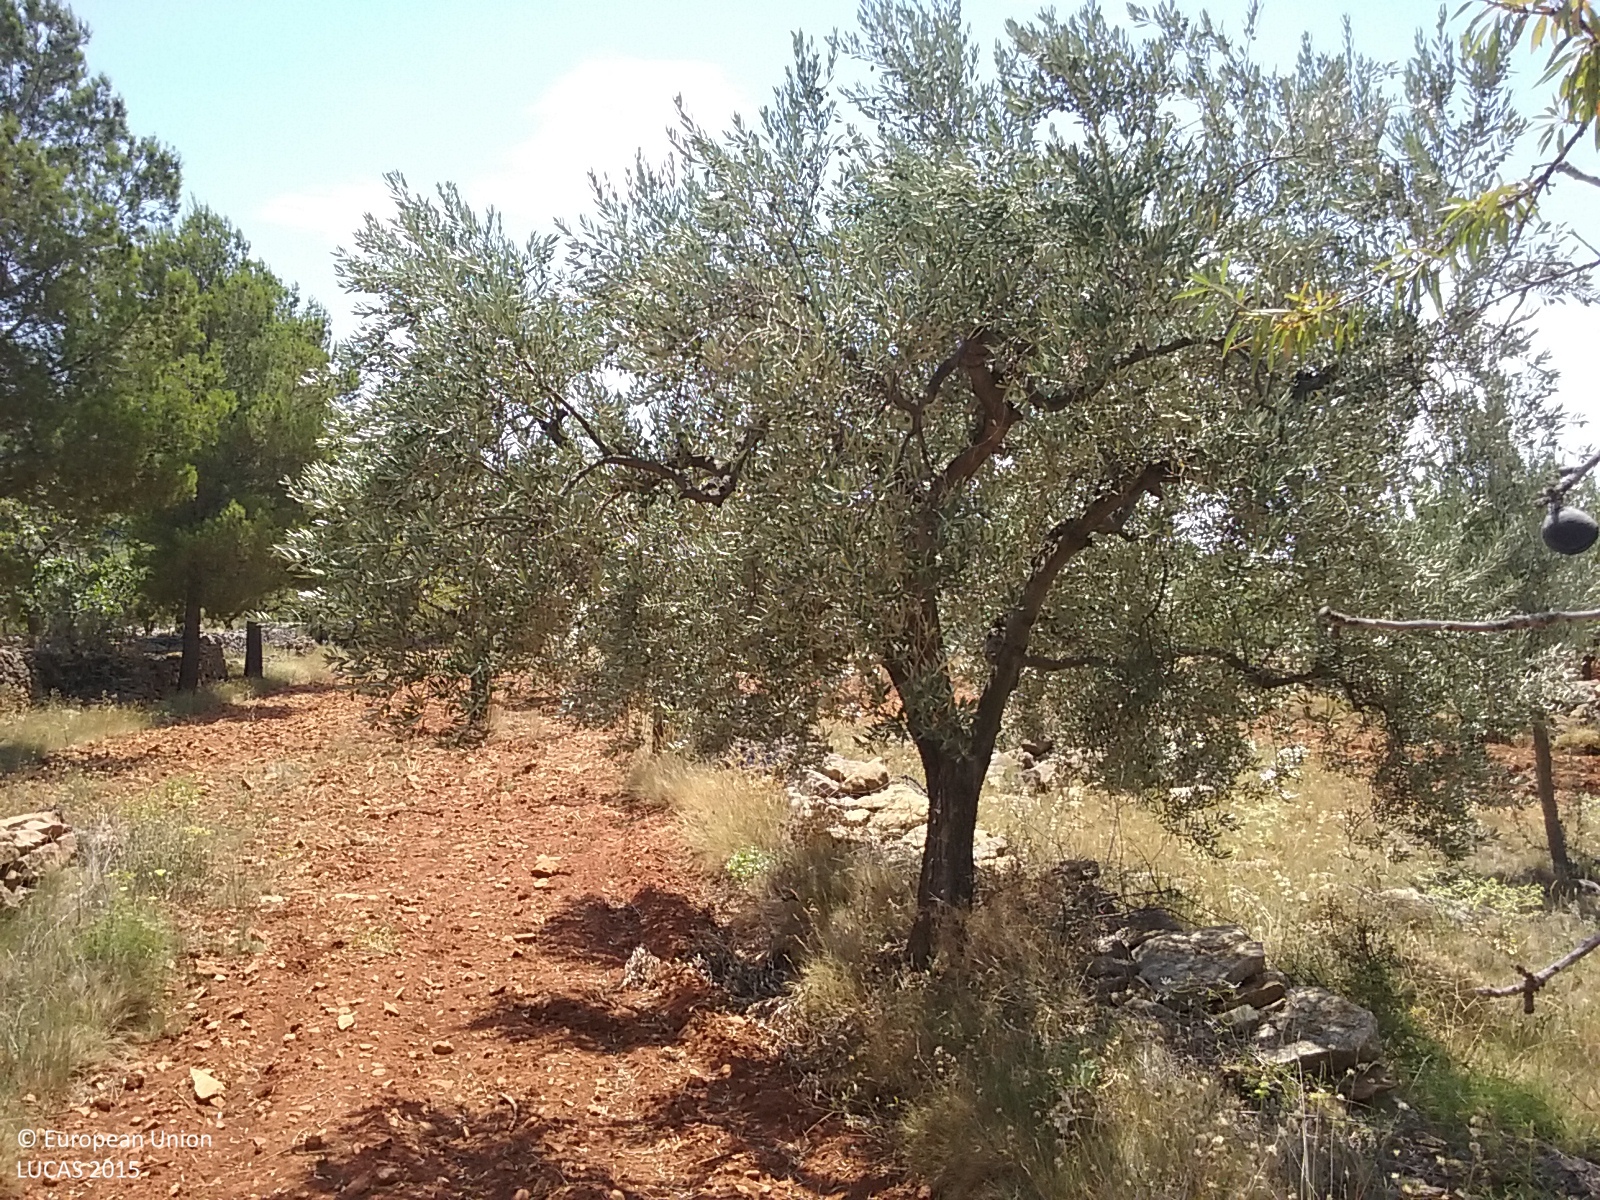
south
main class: Cropland
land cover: Nuts trees
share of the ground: 25 - 50 %
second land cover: Other bare soil
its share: > 75 %
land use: Agriculture (excluding fallow land and kitchen gardens)
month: July
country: ES
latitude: 40.2976
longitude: -0.0391
